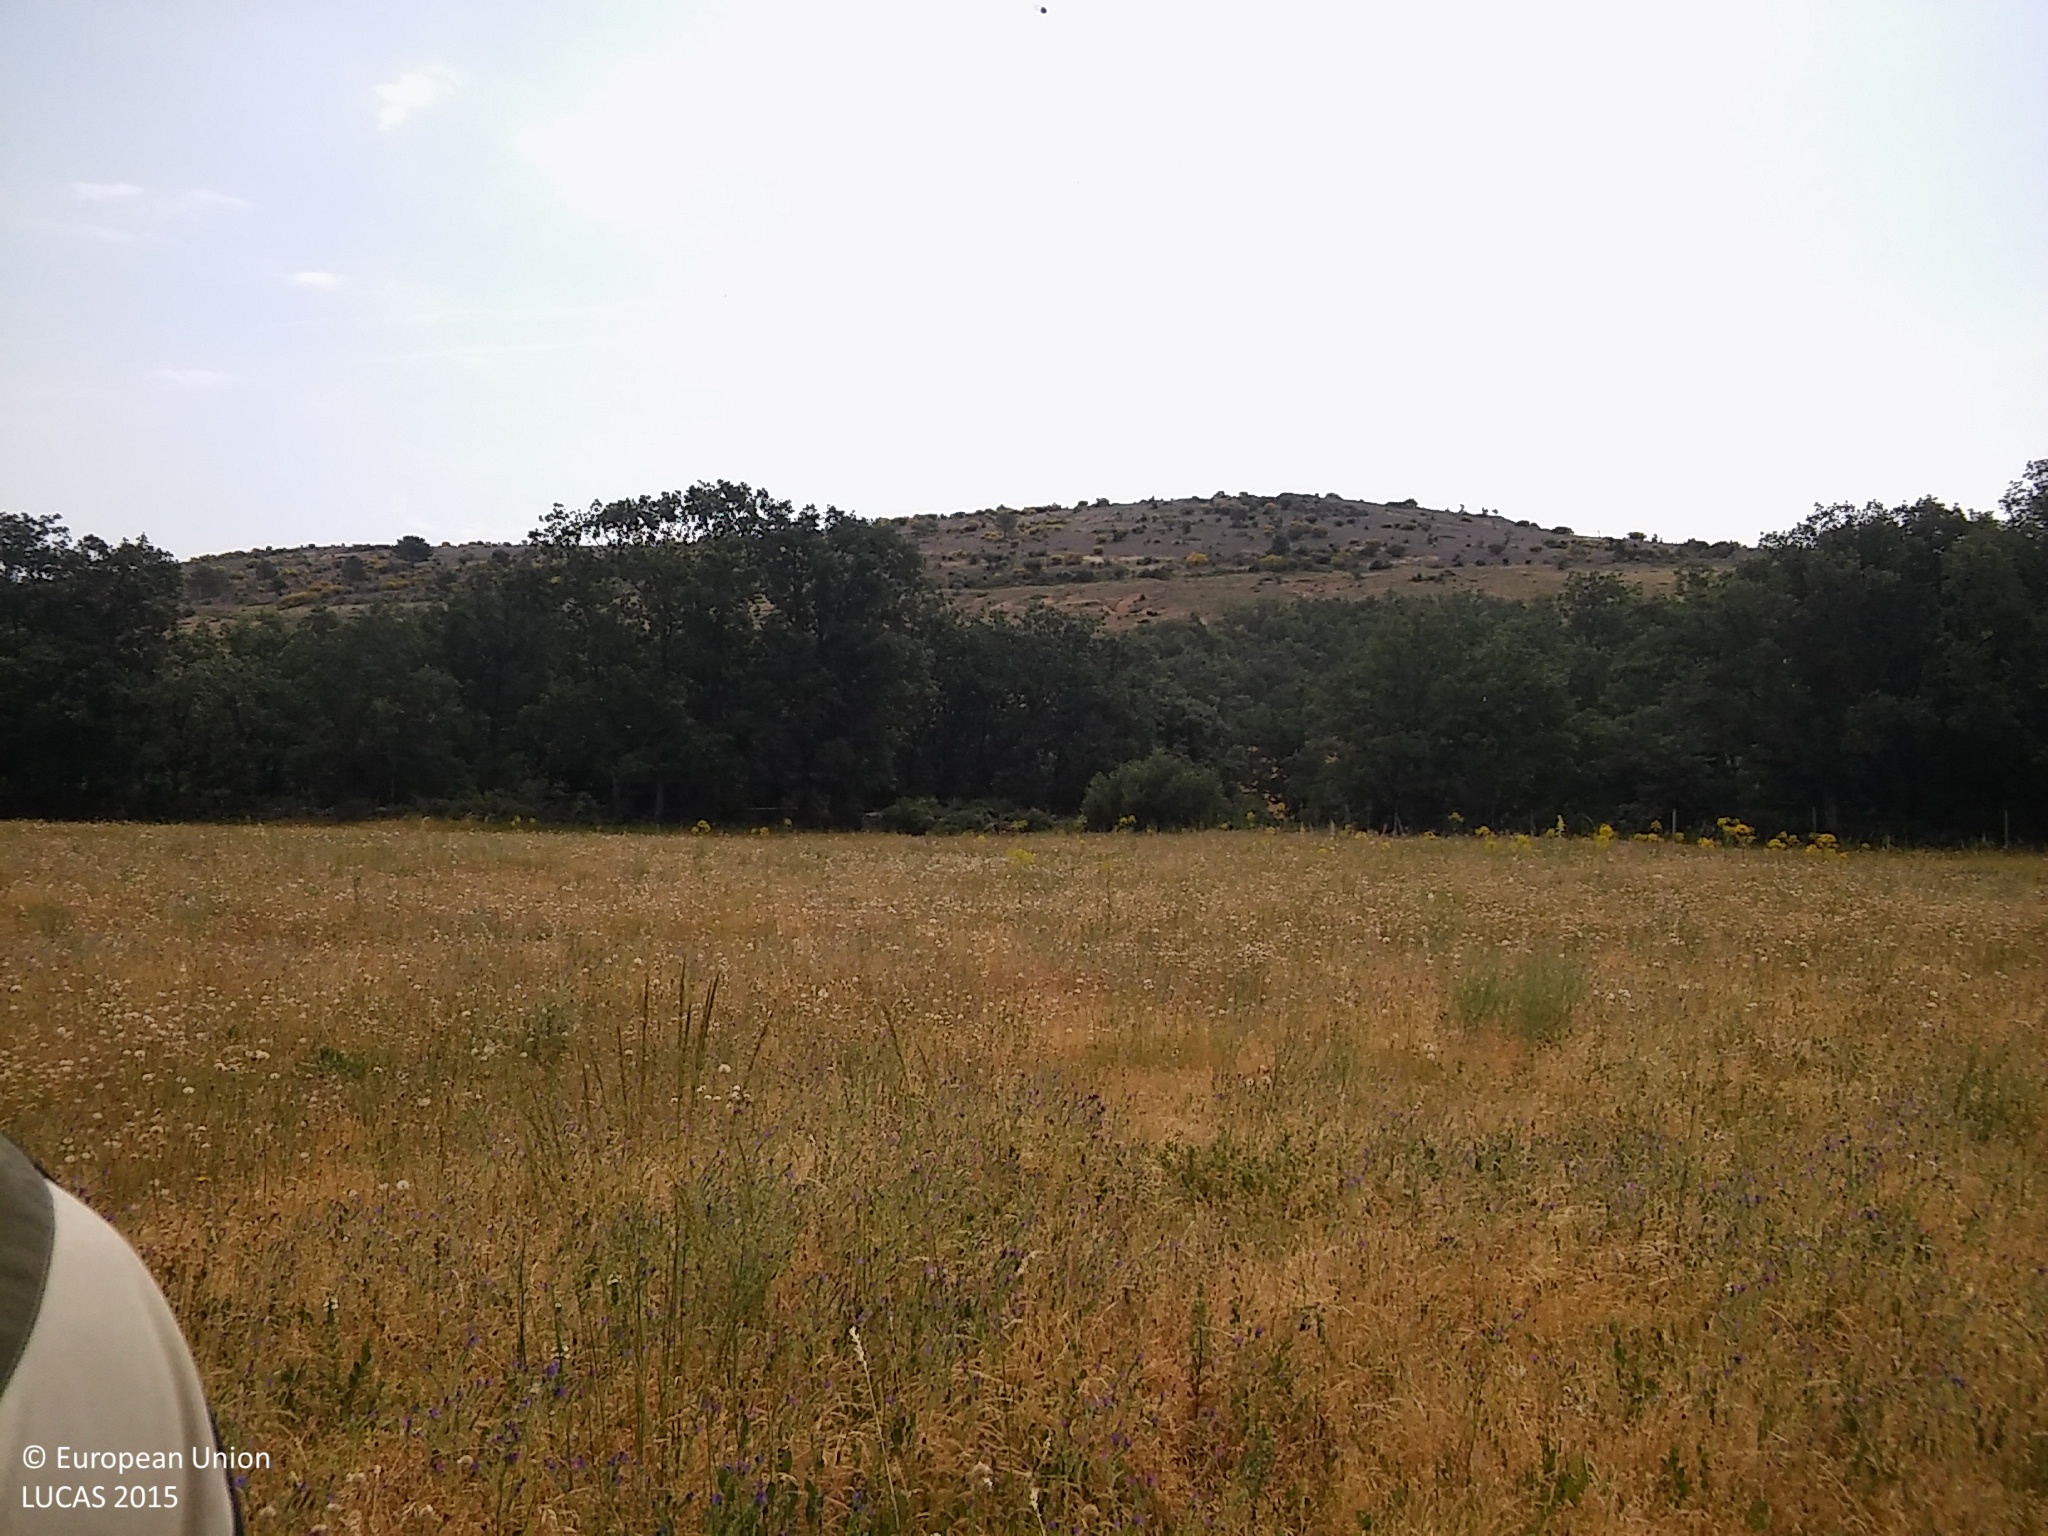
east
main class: Grassland
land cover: Grassland without tree/shrub cover
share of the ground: > 75 %
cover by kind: herbaceous plants 100 %
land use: Agriculture (excluding fallow land and kitchen gardens)
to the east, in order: Grassland without tree/shrub cover; Dry stone walls; Broadleaved woodland; Fences; Shruby margins; Rivers and streams; Shrubland without tree cover; Rock outcrops; Shrubland without tree cover; Grassland without tree/shrub cover
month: June
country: ES
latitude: 41.0490
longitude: -3.6433
